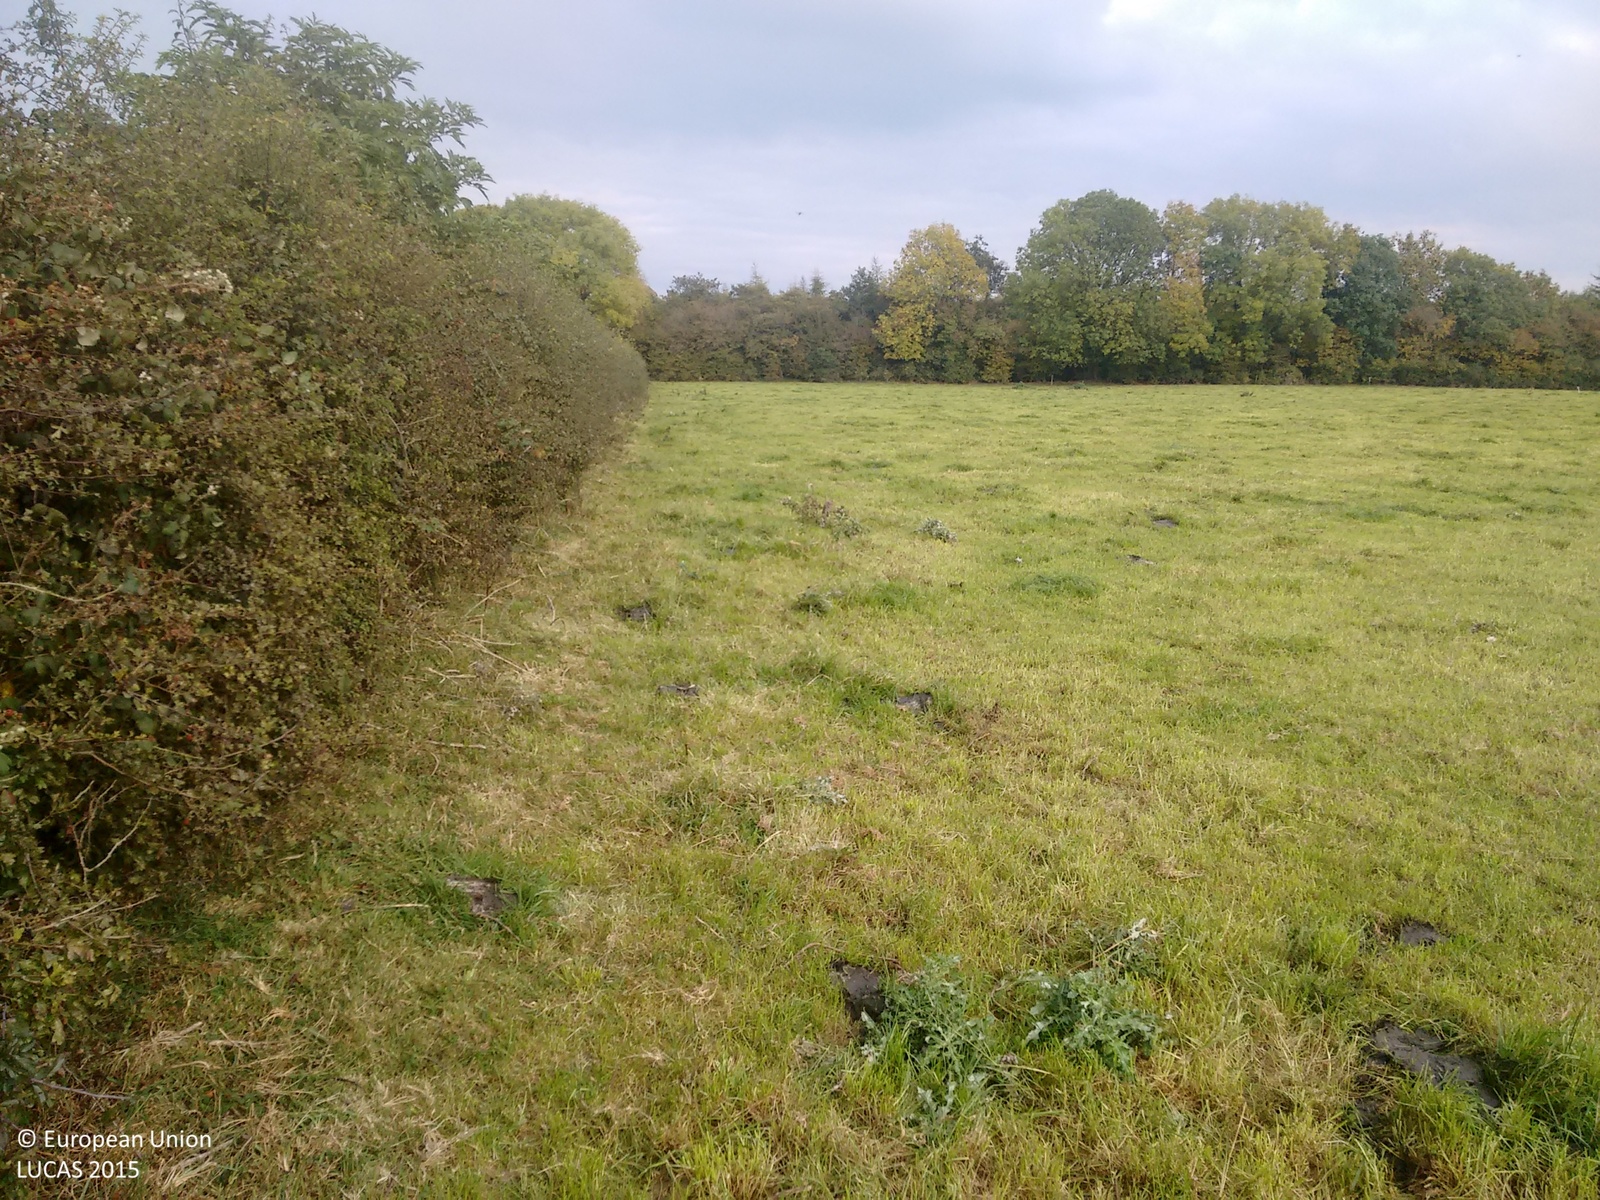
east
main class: Grassland
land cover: Grassland without tree/shrub cover
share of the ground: > 75 %
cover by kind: herbaceous plants 95 %, shrubs 5 %
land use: Agriculture (excluding fallow land and kitchen gardens)
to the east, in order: Managed hedges; Fences; Grassland without tree/shrub cover; Fences; Broadleaved woodland; Ditches and canals; Broadleaved woodland; Other coniferous woodland; Rivers and streams; Other coniferous woodland
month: October
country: IE
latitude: 52.8776
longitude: -7.5601
